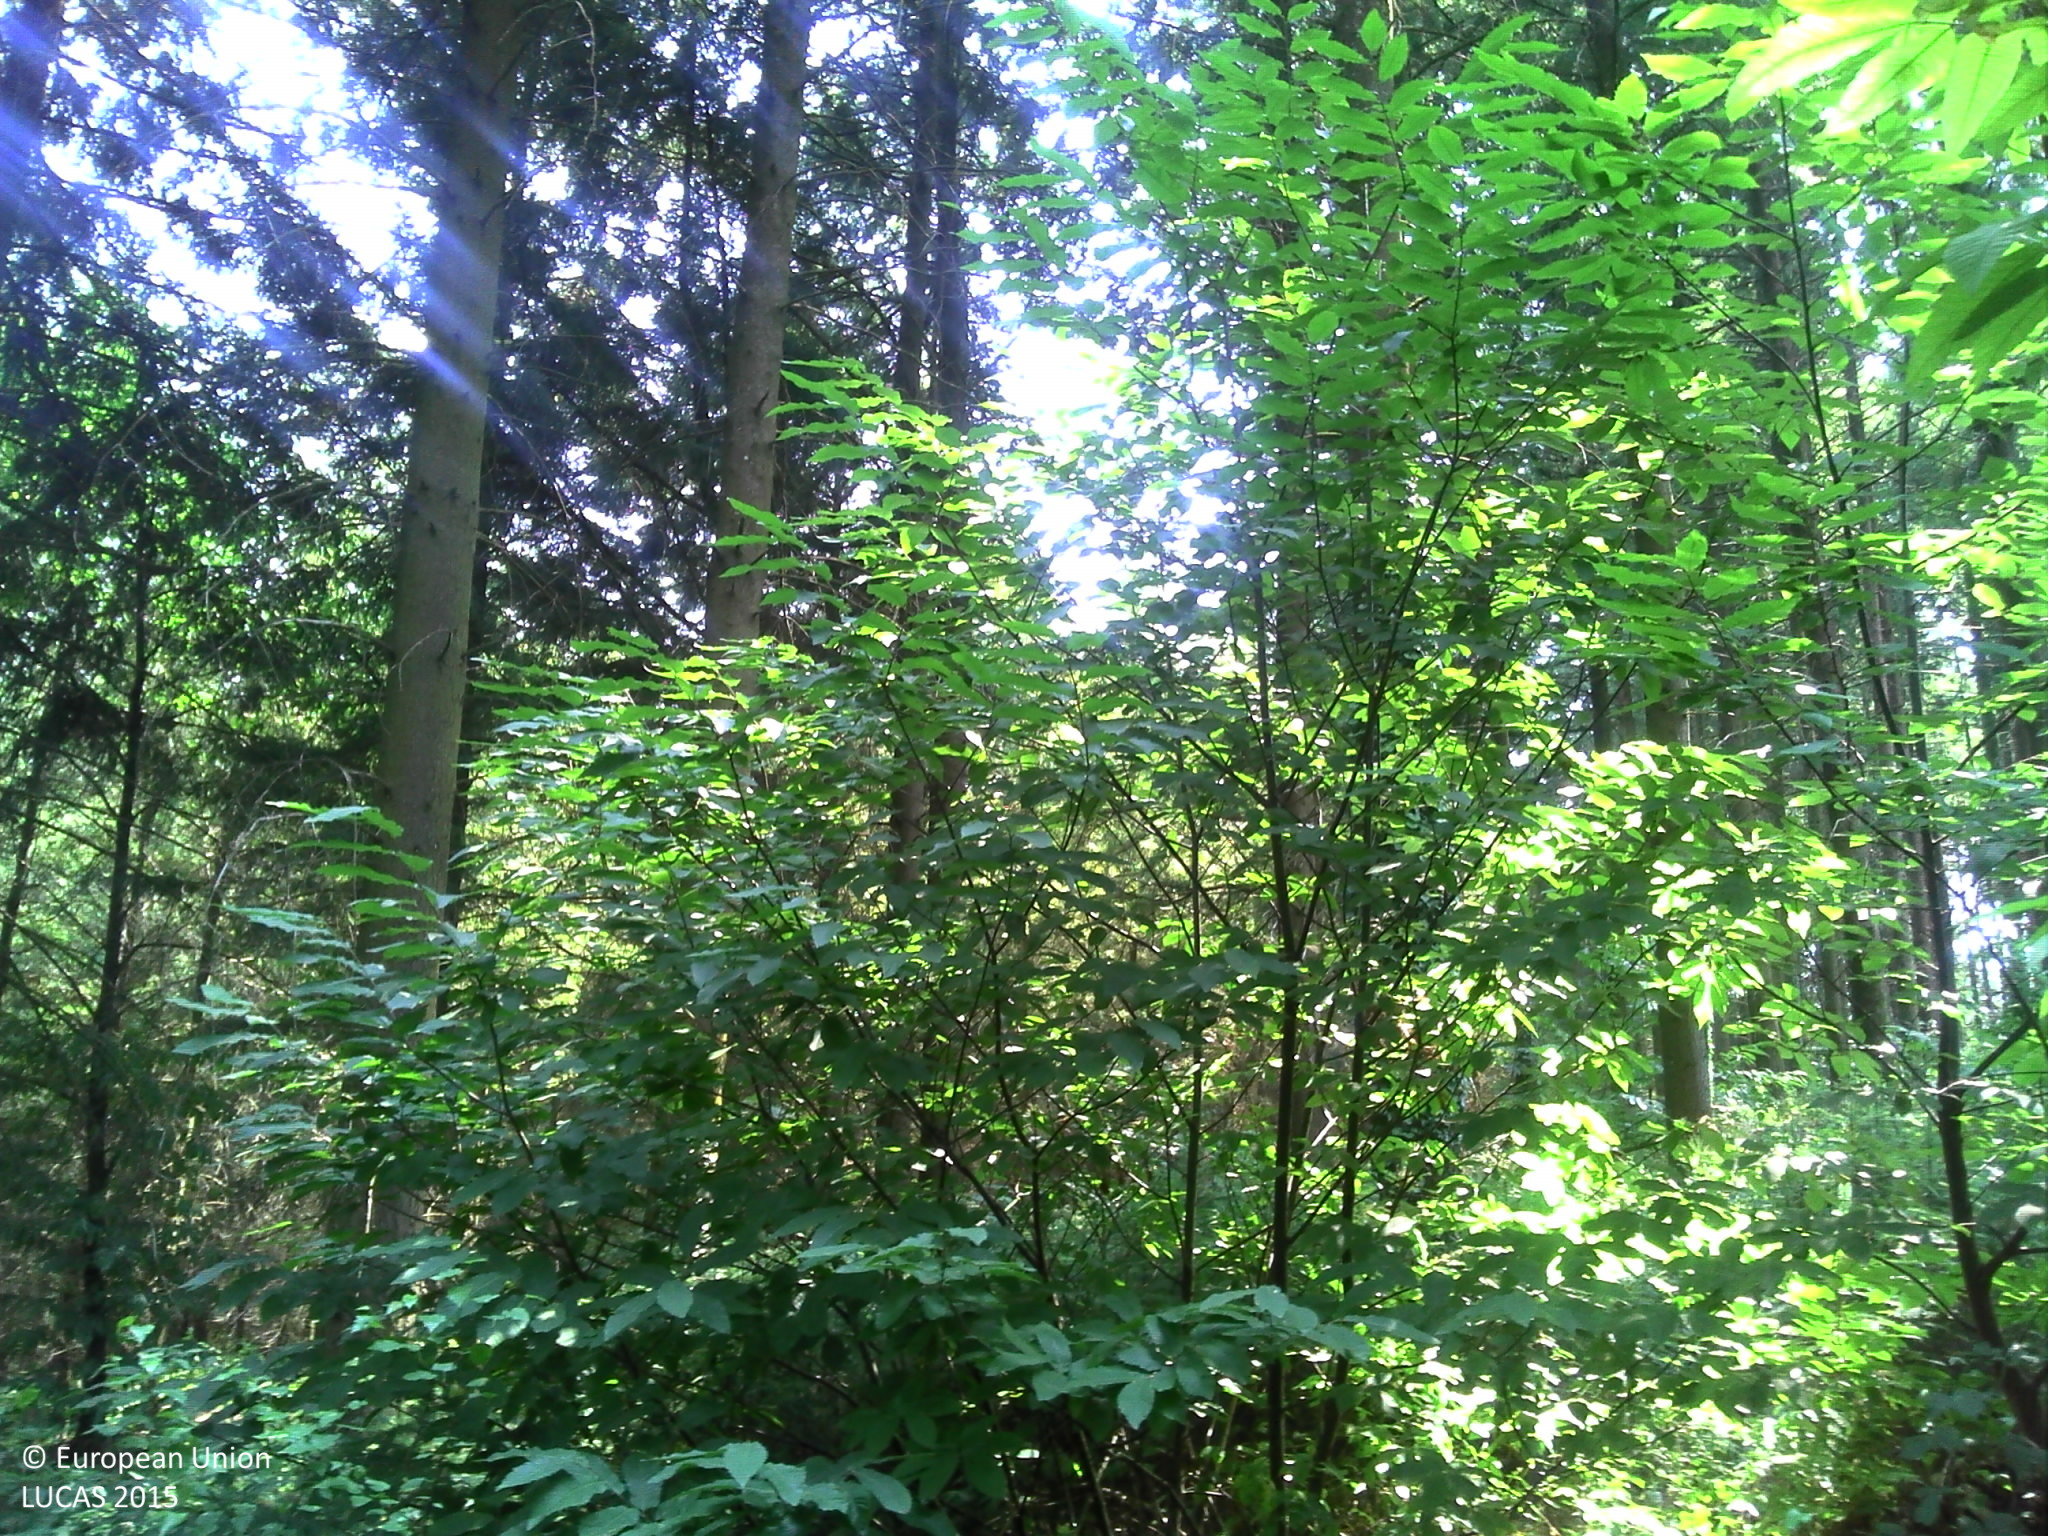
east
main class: Woodland
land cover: Spruce dominated coniferous woodland
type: exotic forest
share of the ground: > 75 %
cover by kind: coniferous forest trees 60 %, broadleaved forest trees 15 %, shrubs 10 %, lichens and mosses 10 %, herbaceous plants 5 %
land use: Forestry
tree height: > 5 m
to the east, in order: Spruce dominated coniferous woodland
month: July
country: FR
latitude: 45.9616
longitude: 1.7738
